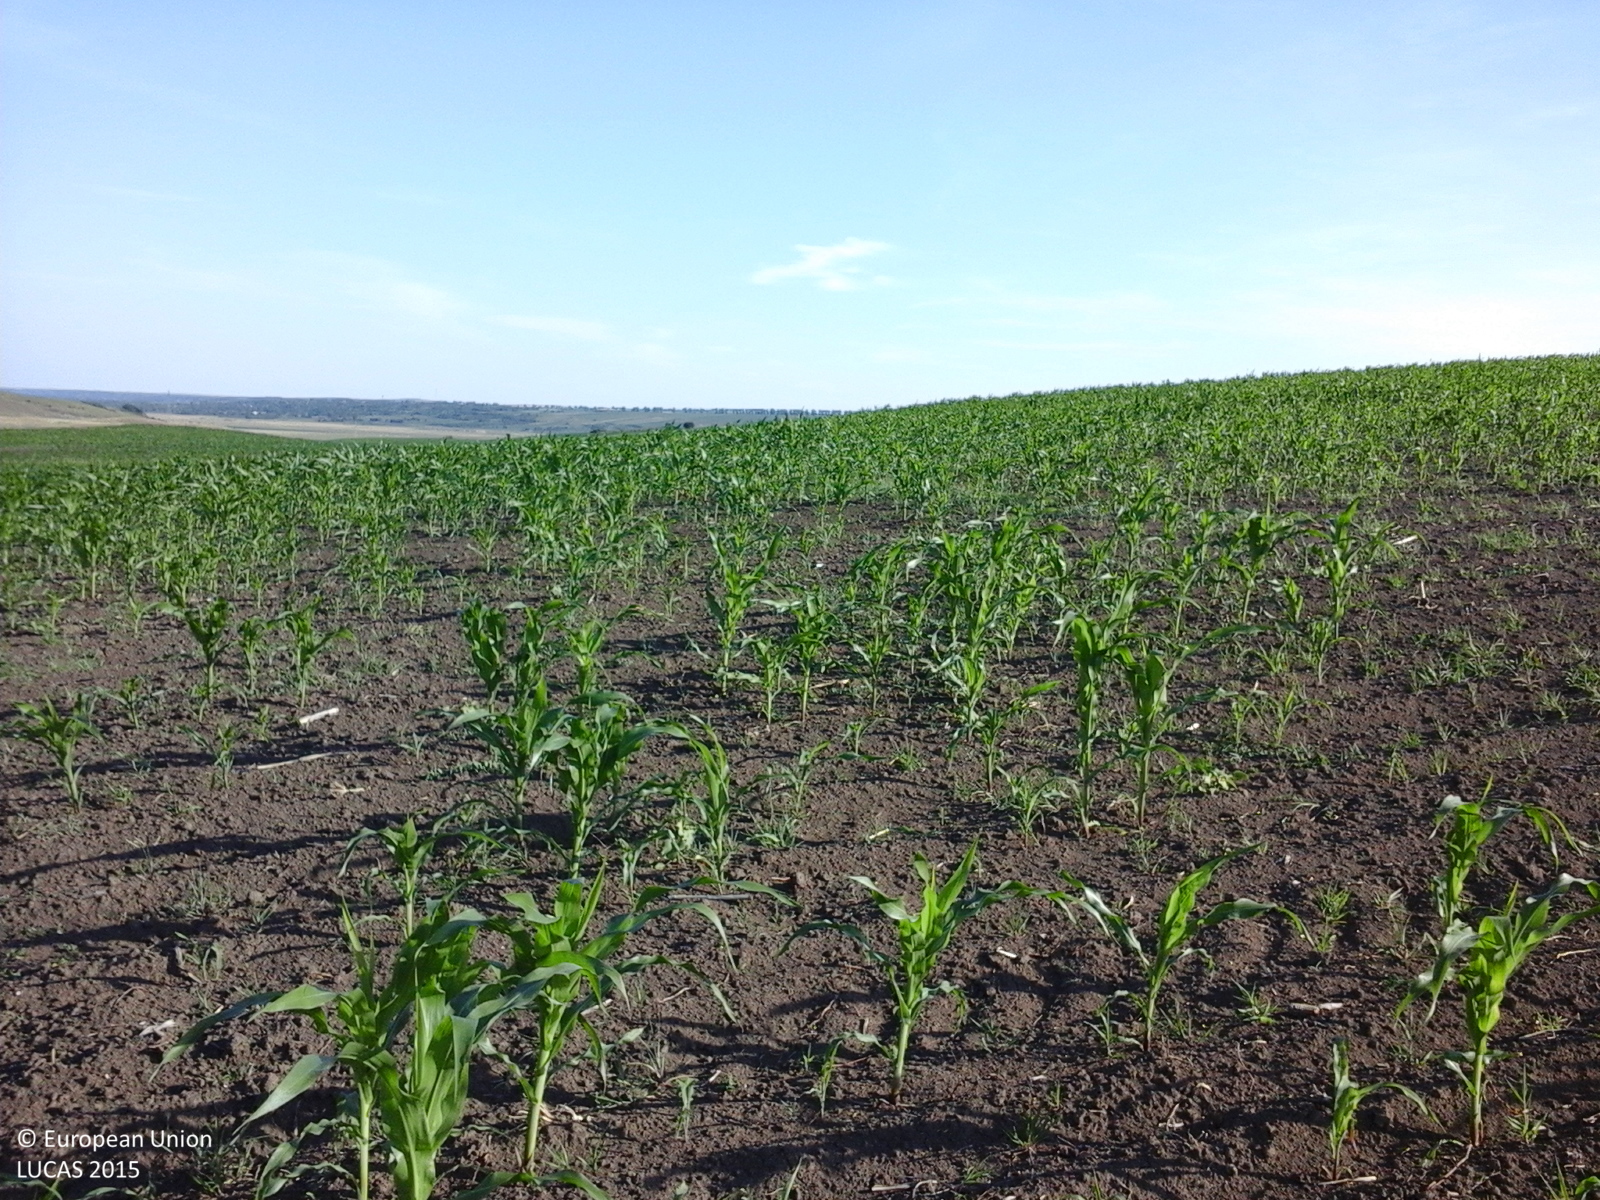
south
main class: Cropland
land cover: Maize
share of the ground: 25 - 50 %
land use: Agriculture (excluding fallow land and kitchen gardens)
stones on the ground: < 10 %
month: June
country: RO
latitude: 47.8374
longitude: 27.1723
